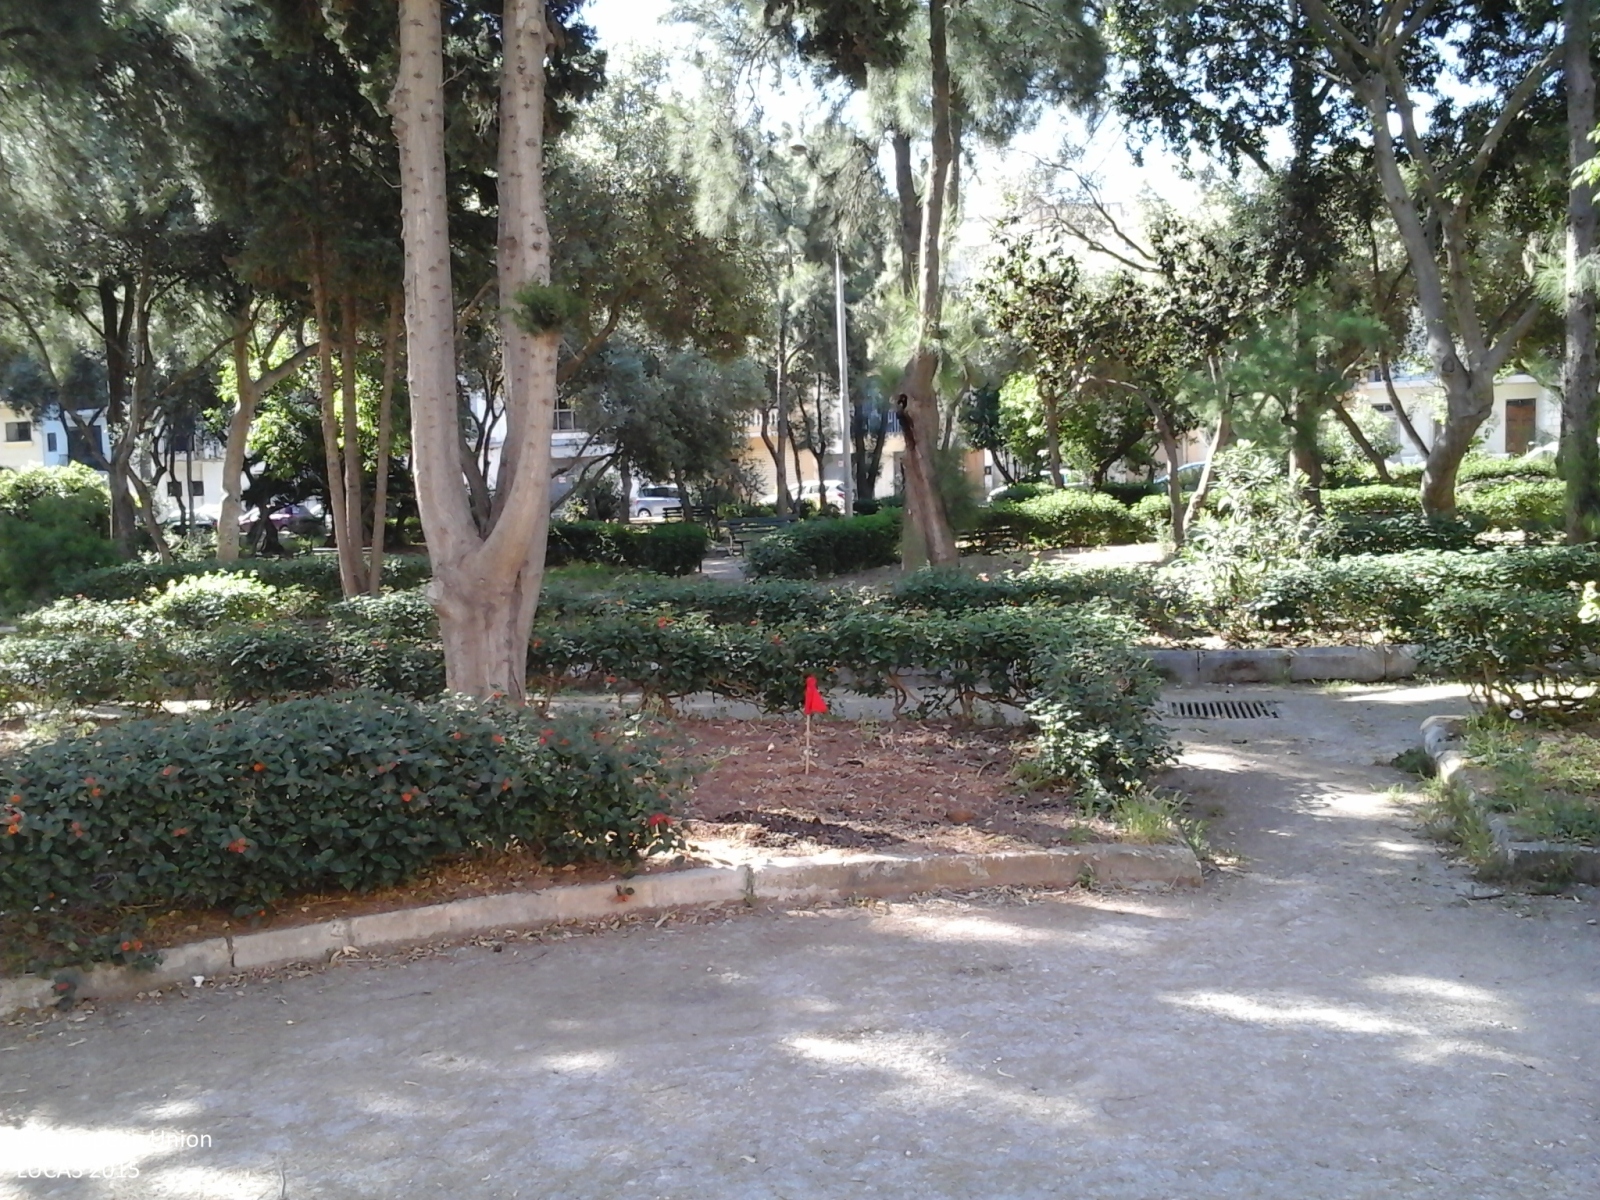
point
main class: Woodland
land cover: Pine dominated coniferous woodland
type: coniferous forest of the mediterranean region
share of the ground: 50 - 75 %
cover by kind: coniferous forest trees 100 %
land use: Amenities, museums, leisure
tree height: > 5 m
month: May
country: MT
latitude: 35.8753
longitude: 14.5105
